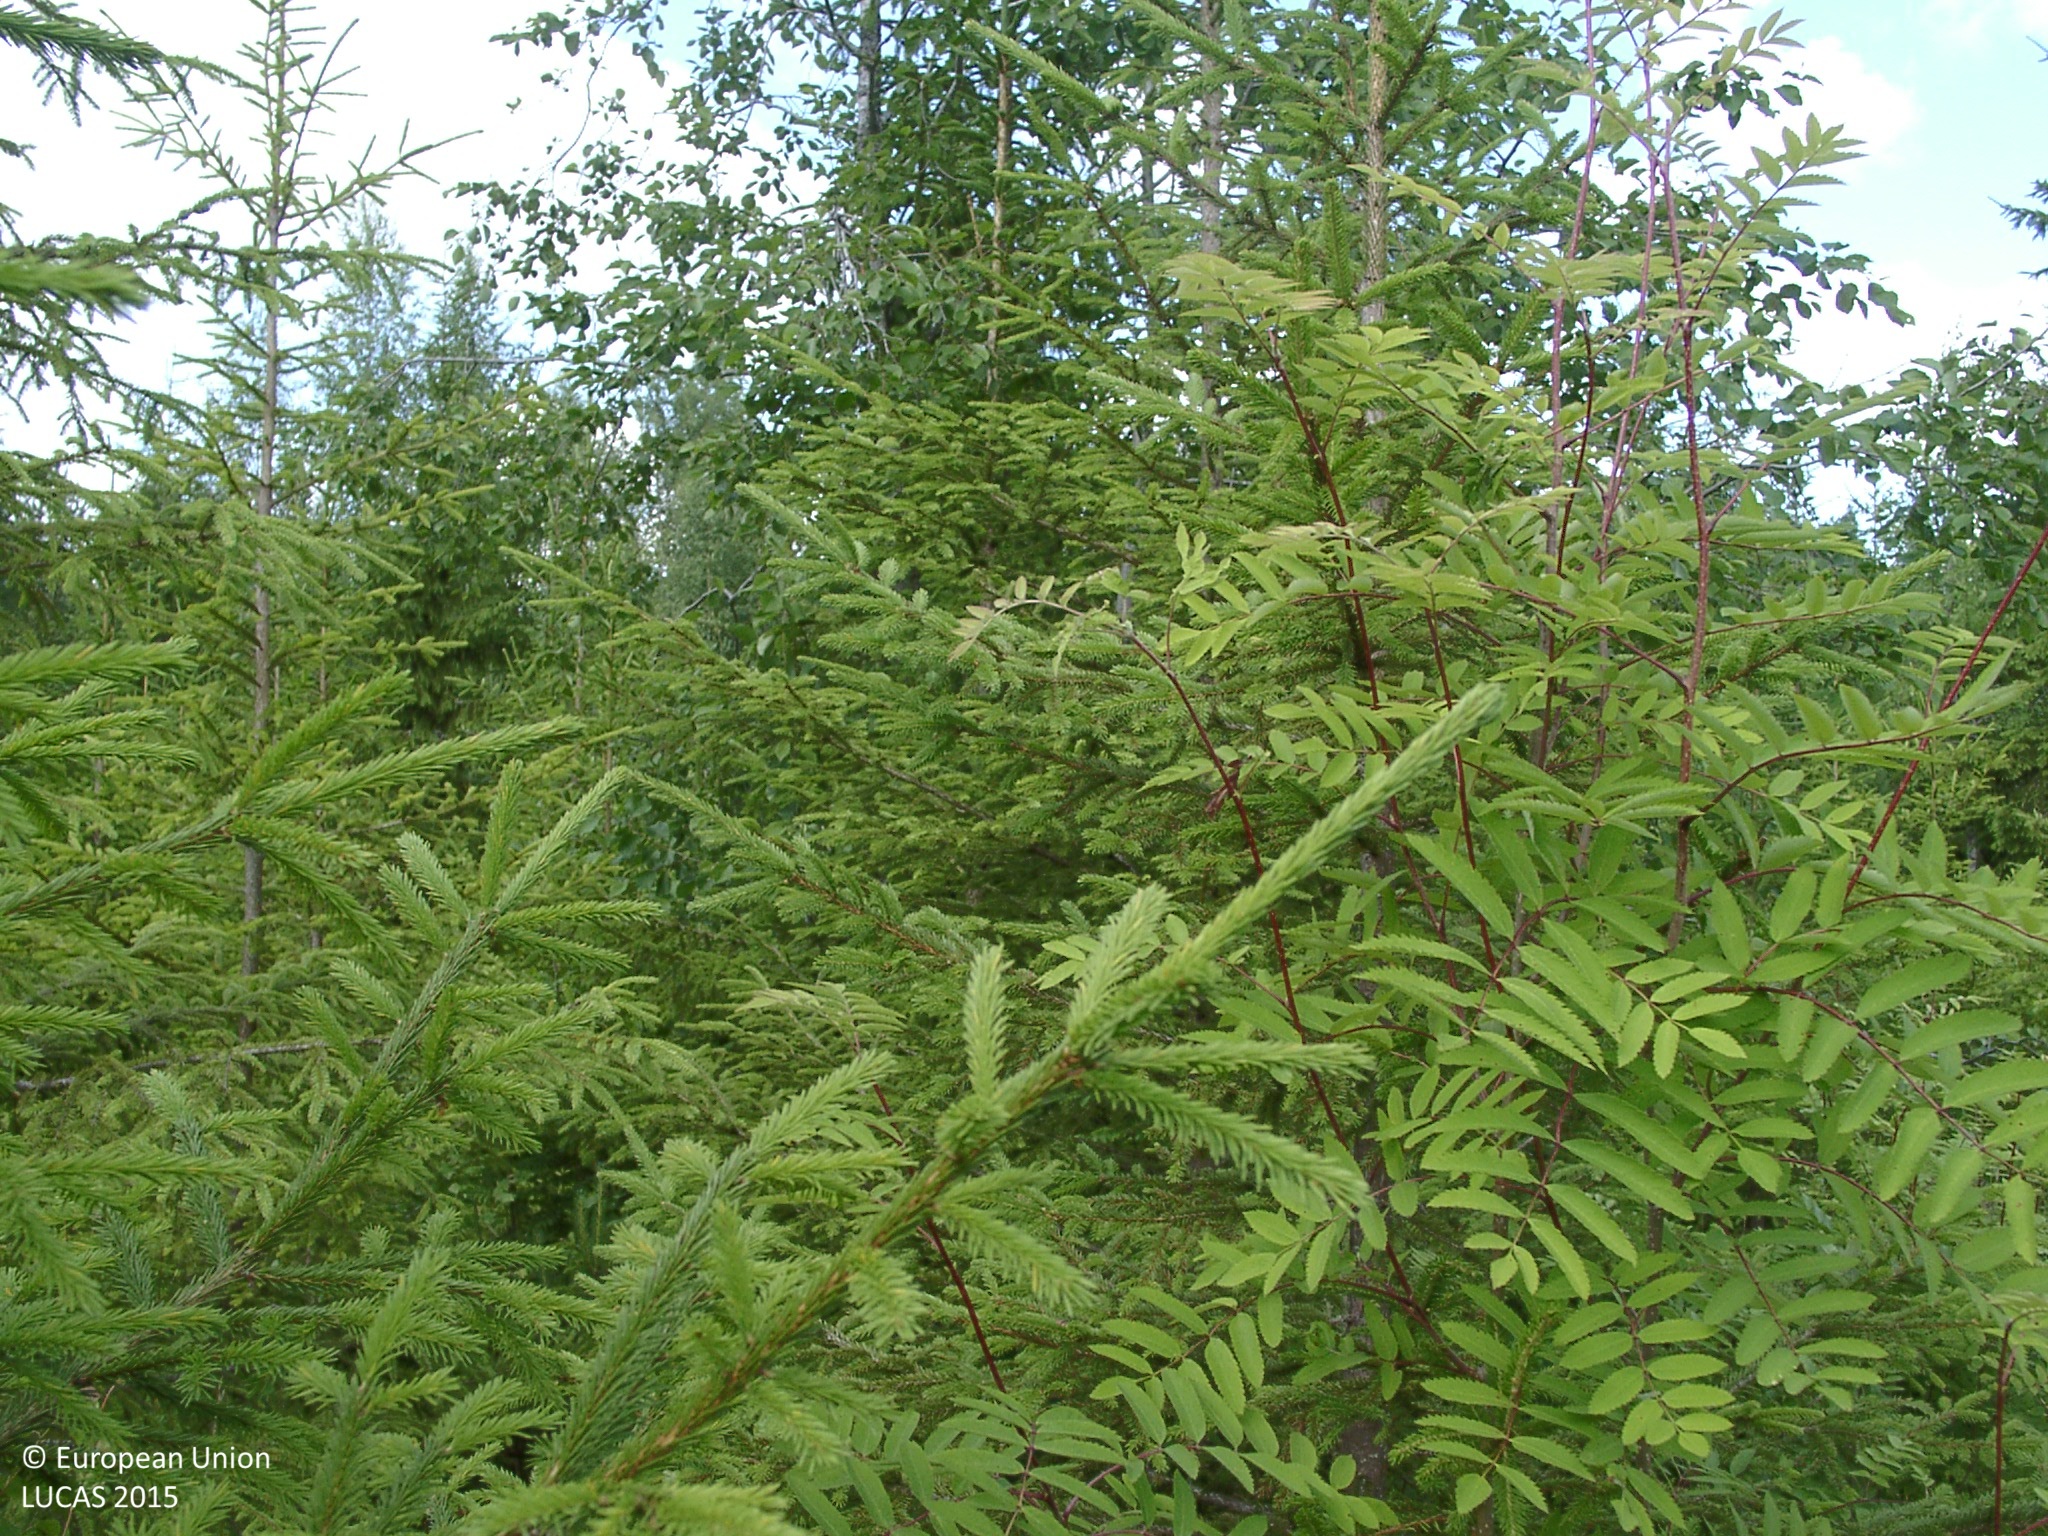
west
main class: Woodland
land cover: Spruce dominated mixed woodland
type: boreal forest
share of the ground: 50 - 75 %
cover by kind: coniferous forest trees 45 %, broadleaved forest trees 20 %, shrubs 20 %, herbaceous plants 15 %
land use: Forestry
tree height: < 5 m
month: July
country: FI
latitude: 61.5816
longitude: 24.9697
